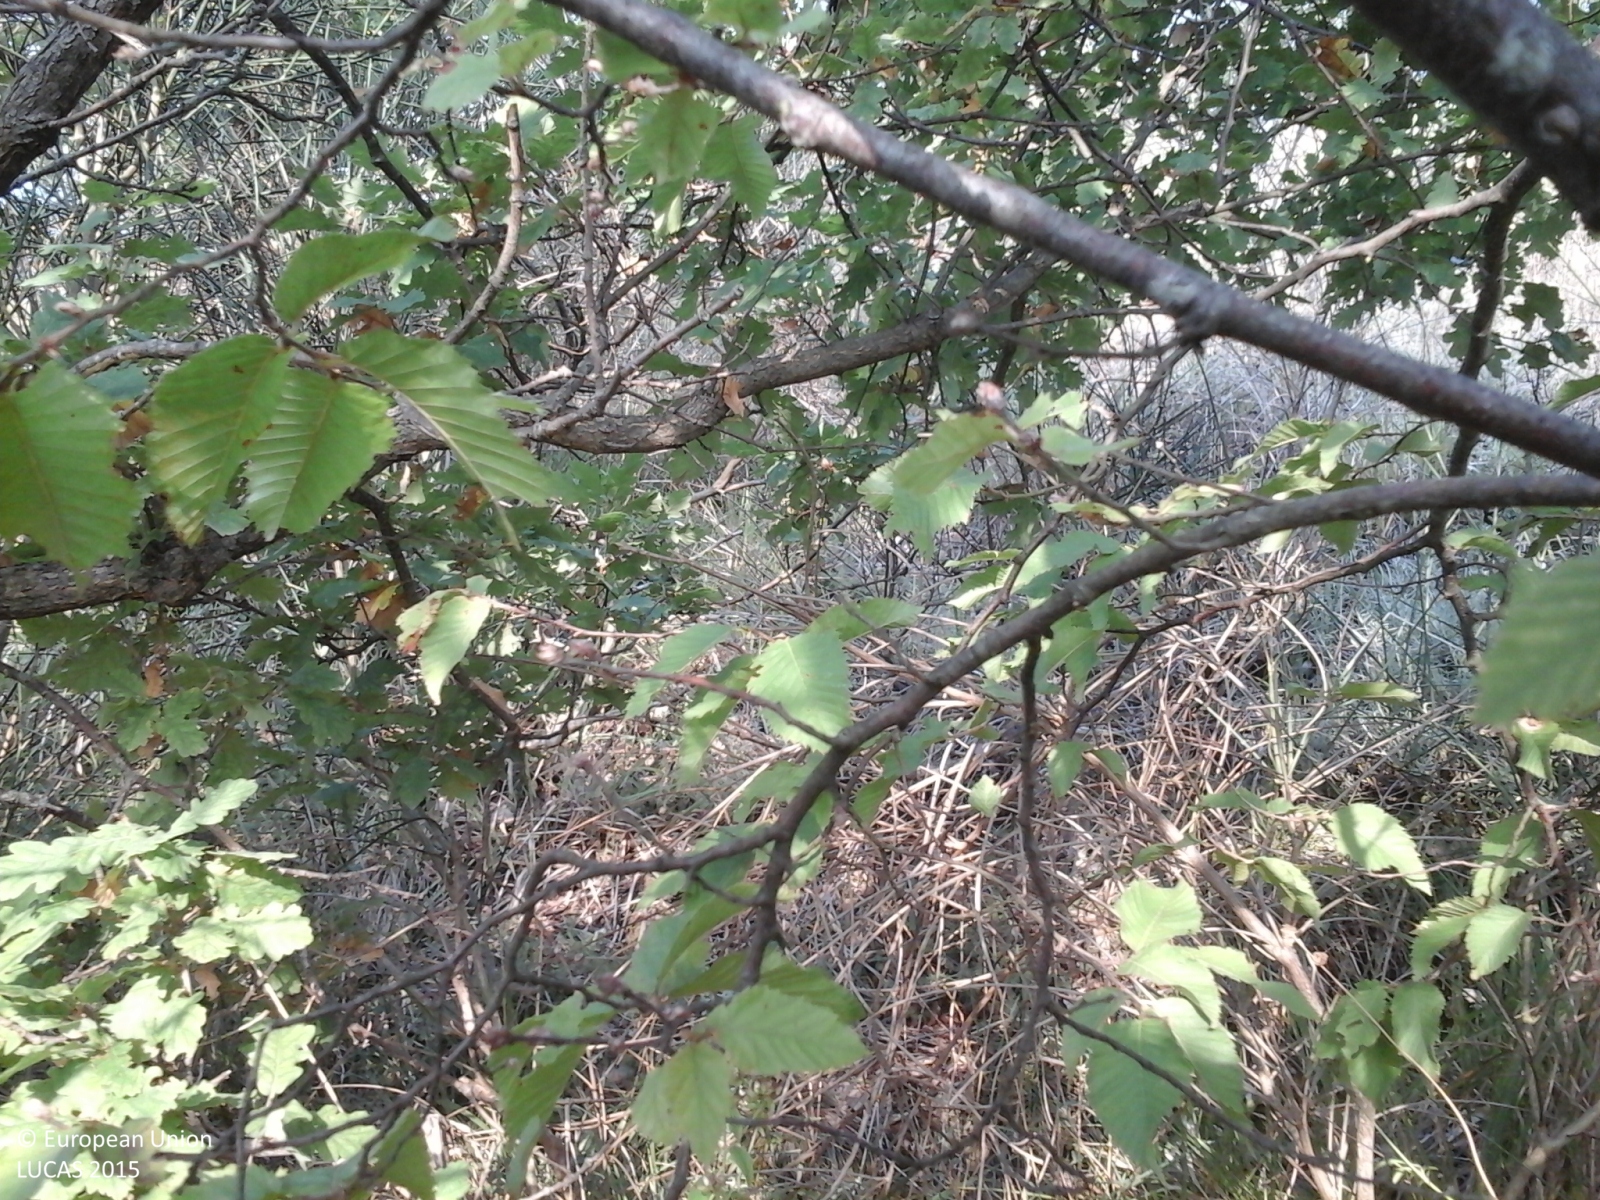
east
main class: Woodland
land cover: Broadleaved woodland
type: thermophilous deciduous forest
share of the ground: > 75 %
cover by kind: broadleaved forest trees 90 %, shrubs 5 %, herbaceous plants 5 %
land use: Forestry
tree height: > 5 m
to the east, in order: Broadleaved woodland; Electric lines; Broadleaved woodland; Paved roads, cycling and walking lanes; Broadleaved woodland; Lucerne; Broadleaved woodland; Durum wheat; Lucerne; Broadleaved woodland
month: August
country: IT
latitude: 43.4003
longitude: 13.1405
